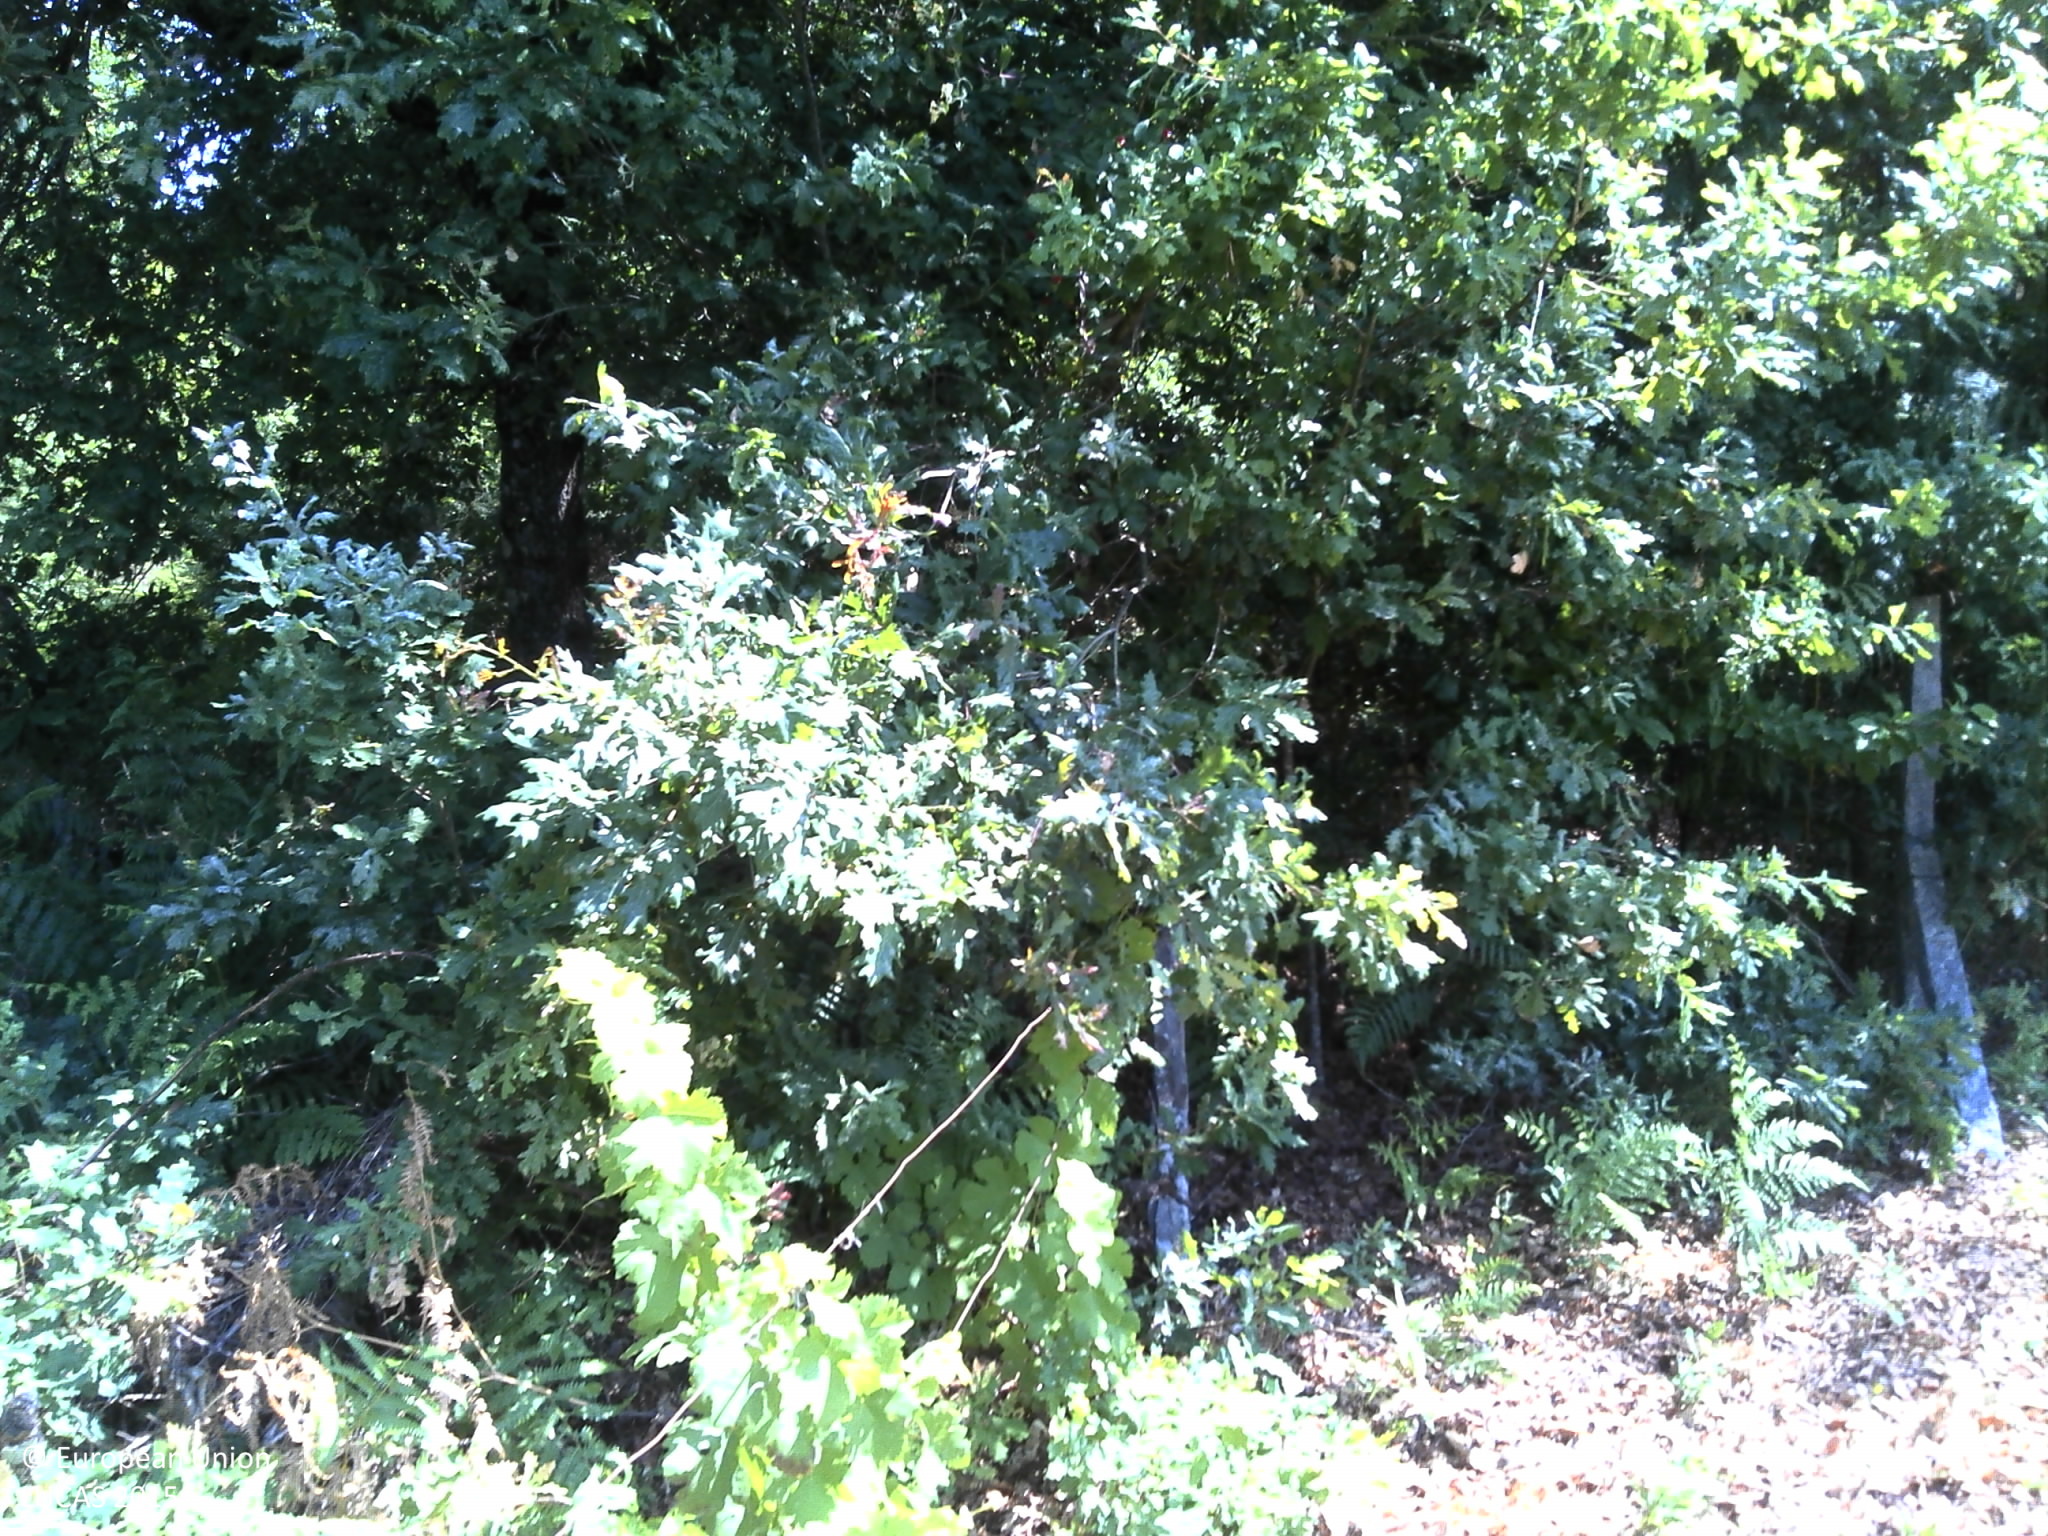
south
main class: Cropland
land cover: Vineyards
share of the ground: 10 - 25 %
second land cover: Grassland without tree/shrub cover
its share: 50 - 75 %
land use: Agriculture (excluding fallow land and kitchen gardens)
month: July
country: PT
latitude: 40.7476
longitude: -7.8053
